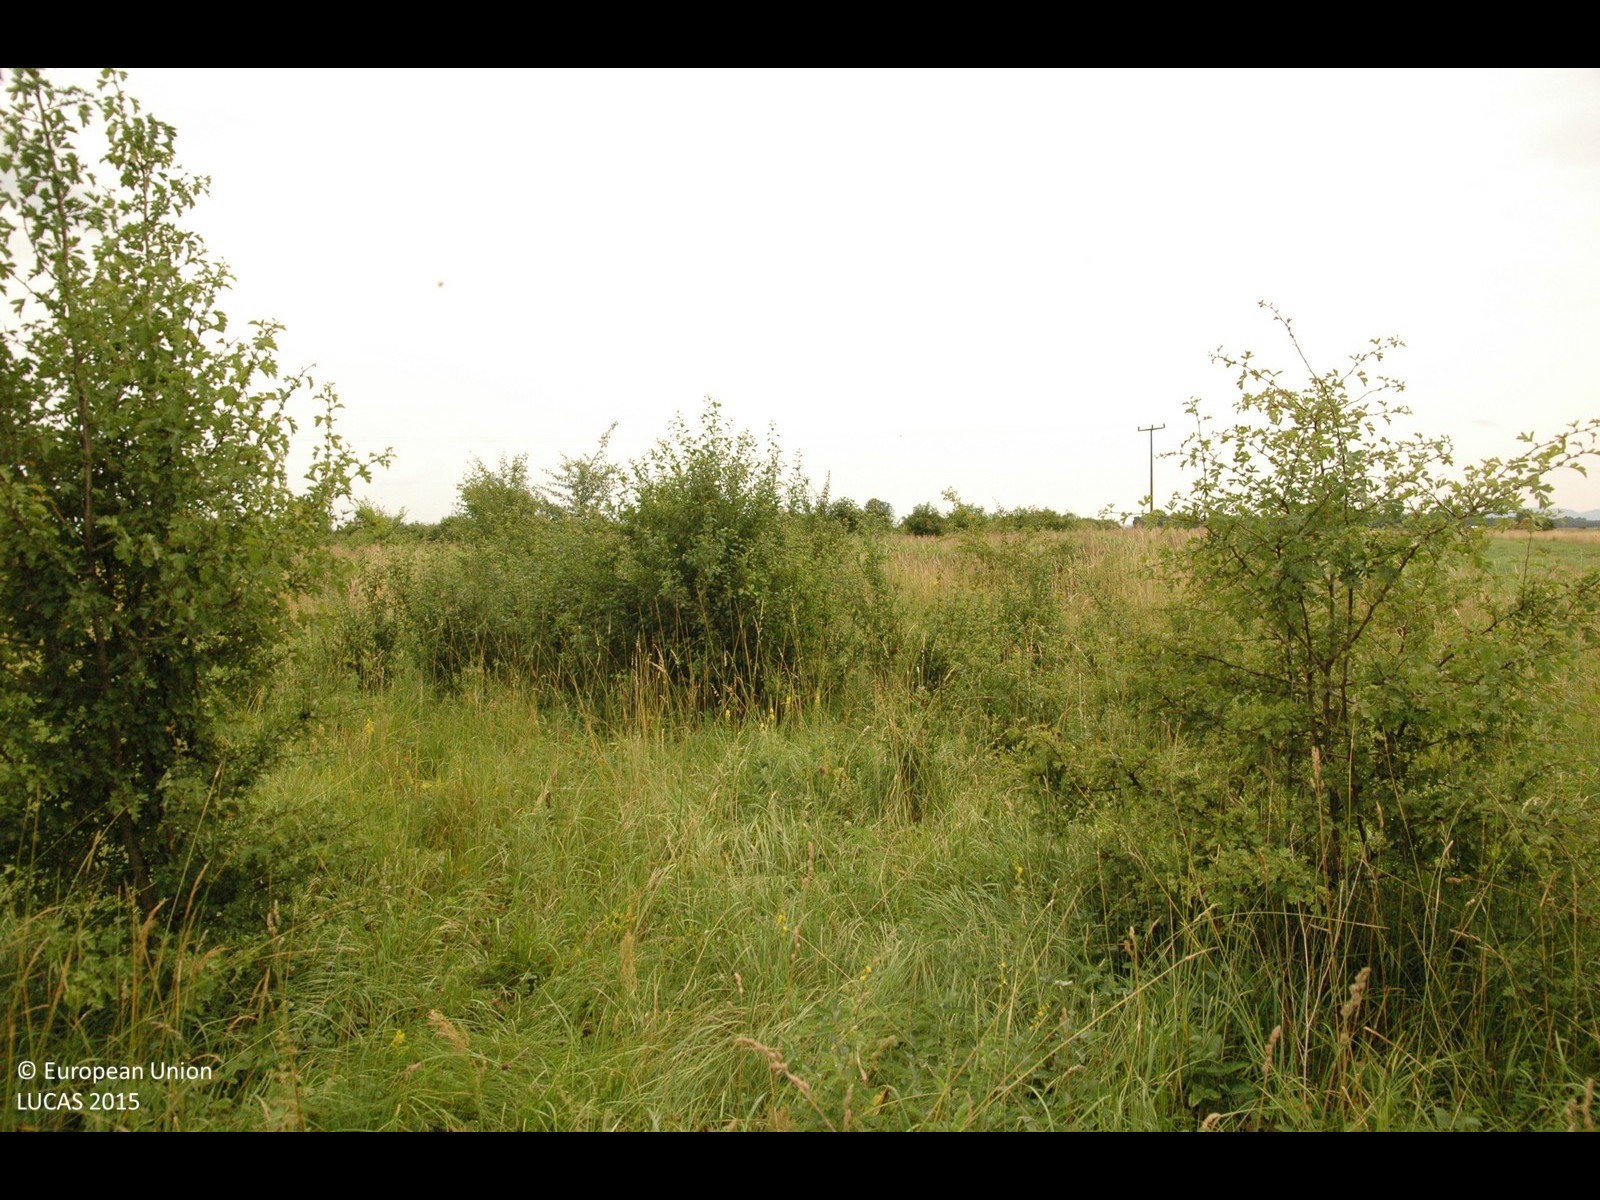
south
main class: Grassland
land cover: Grassland with sparse tree/shrub cover
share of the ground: > 75 %
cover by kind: herbaceous plants 85 %, shrubs 10 %, broadleaved forest trees 5 %
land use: Abandoned areas
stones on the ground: < 10 %
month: June
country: HR
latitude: 46.3788
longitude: 16.3581
